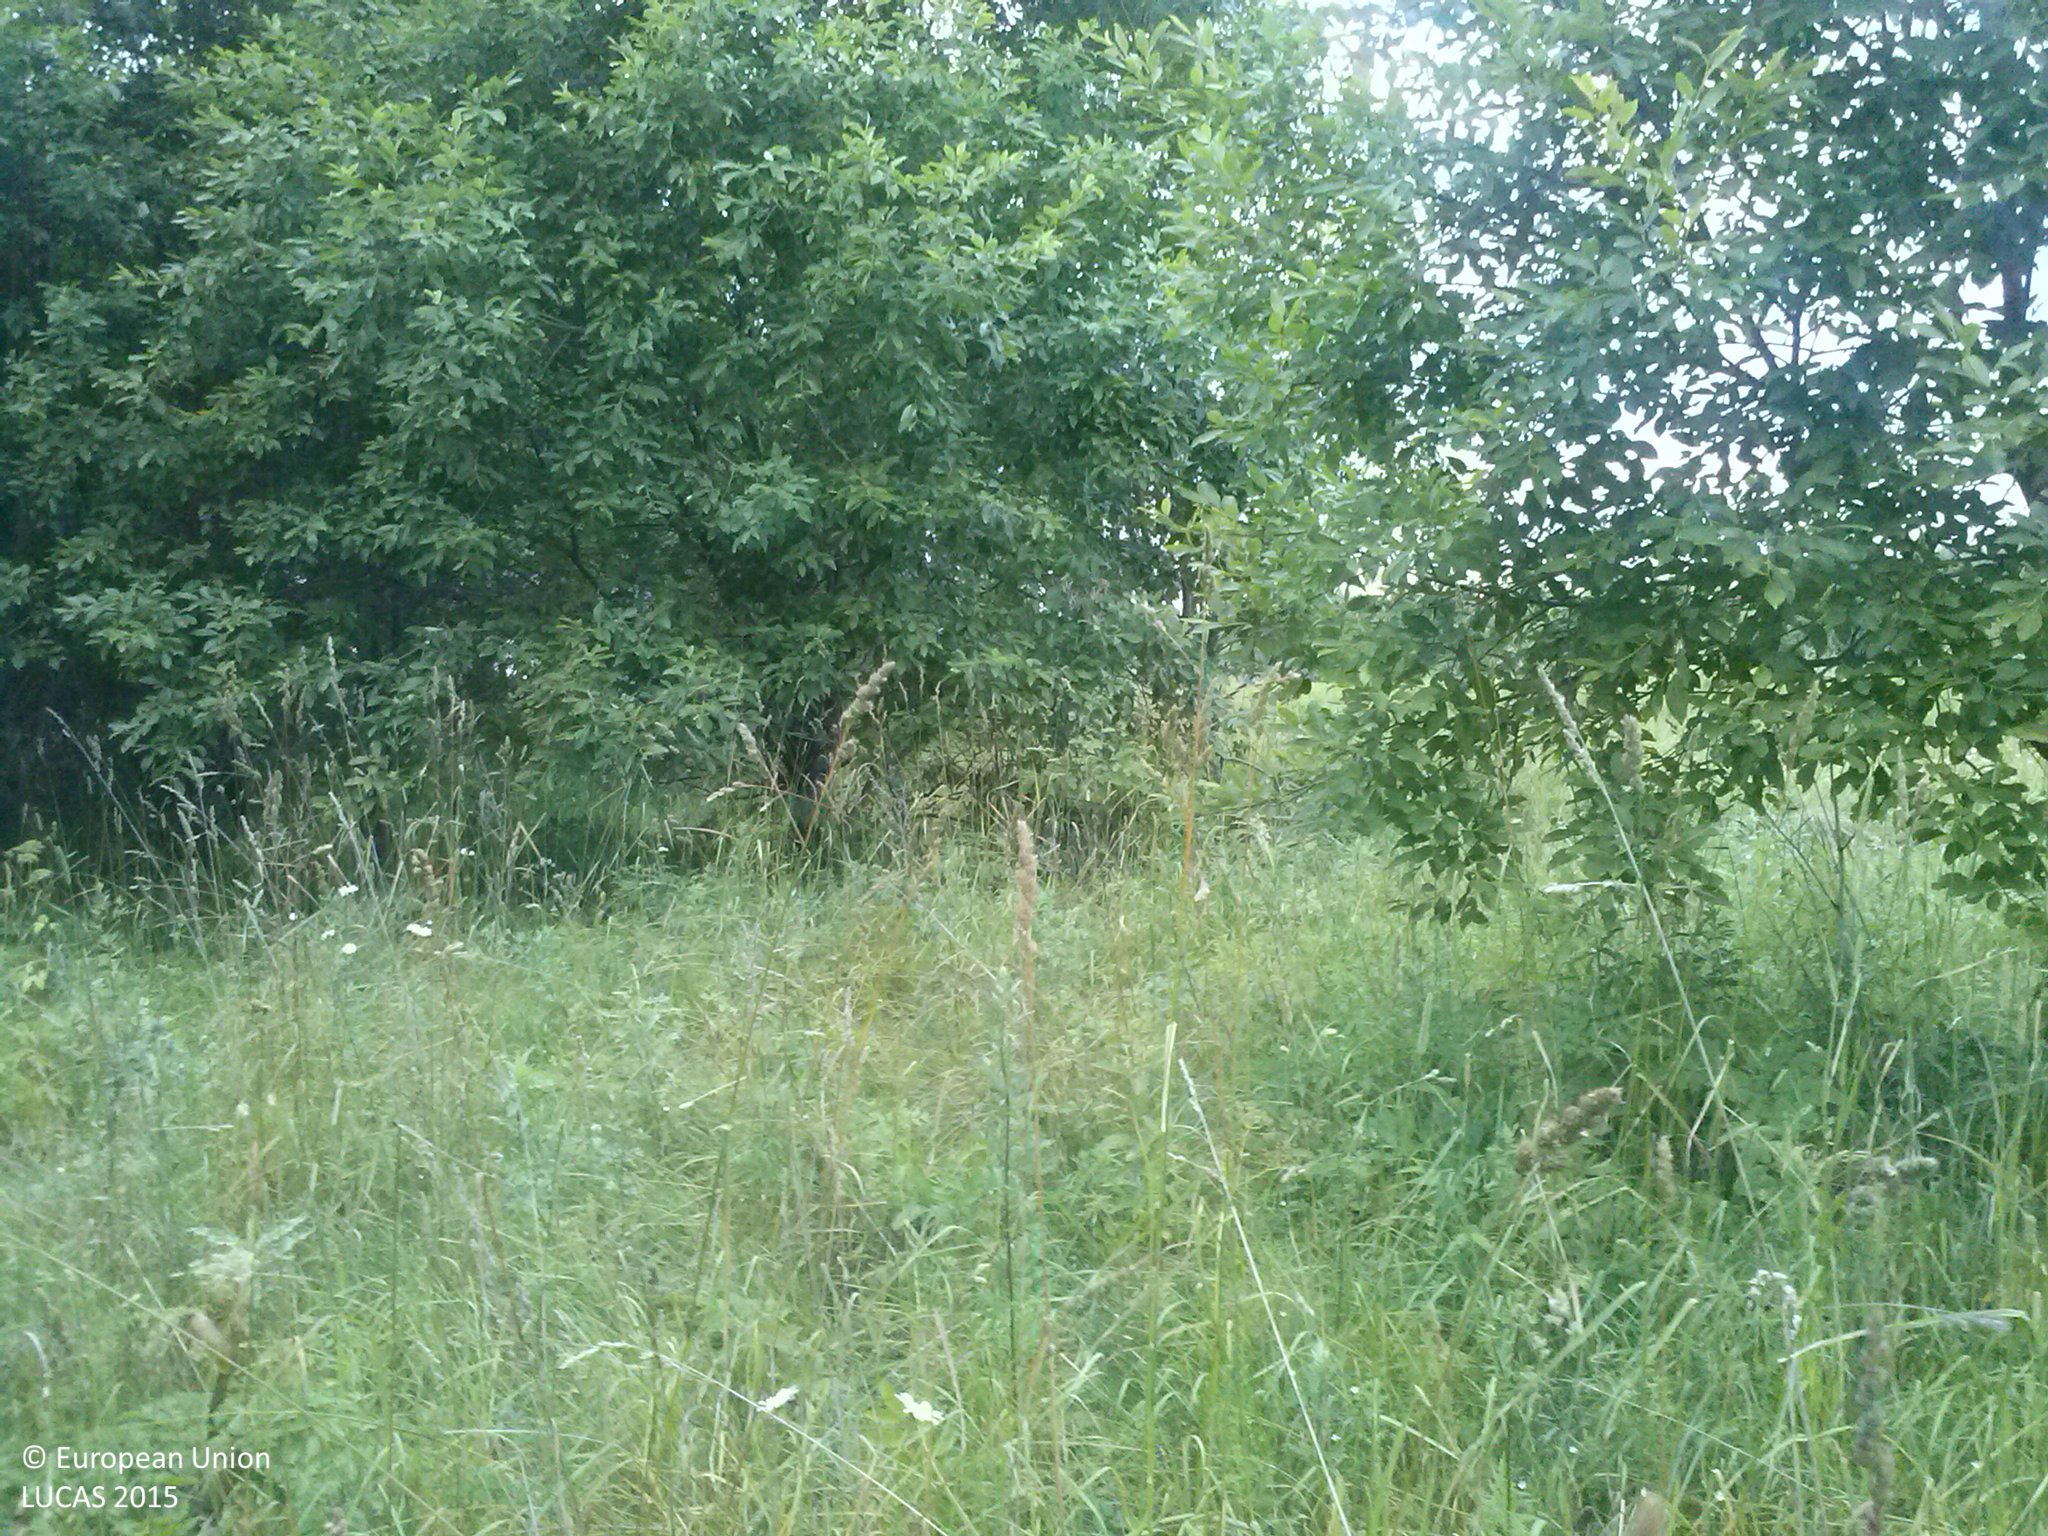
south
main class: Grassland
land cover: Grassland with sparse tree/shrub cover
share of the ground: > 75 %
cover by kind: herbaceous plants 85 %, shrubs 10 %, broadleaved forest trees 5 %
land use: Semi-natural and natural areas not in use
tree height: < 5 m
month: July
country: LV
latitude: 56.7565
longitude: 27.6682
